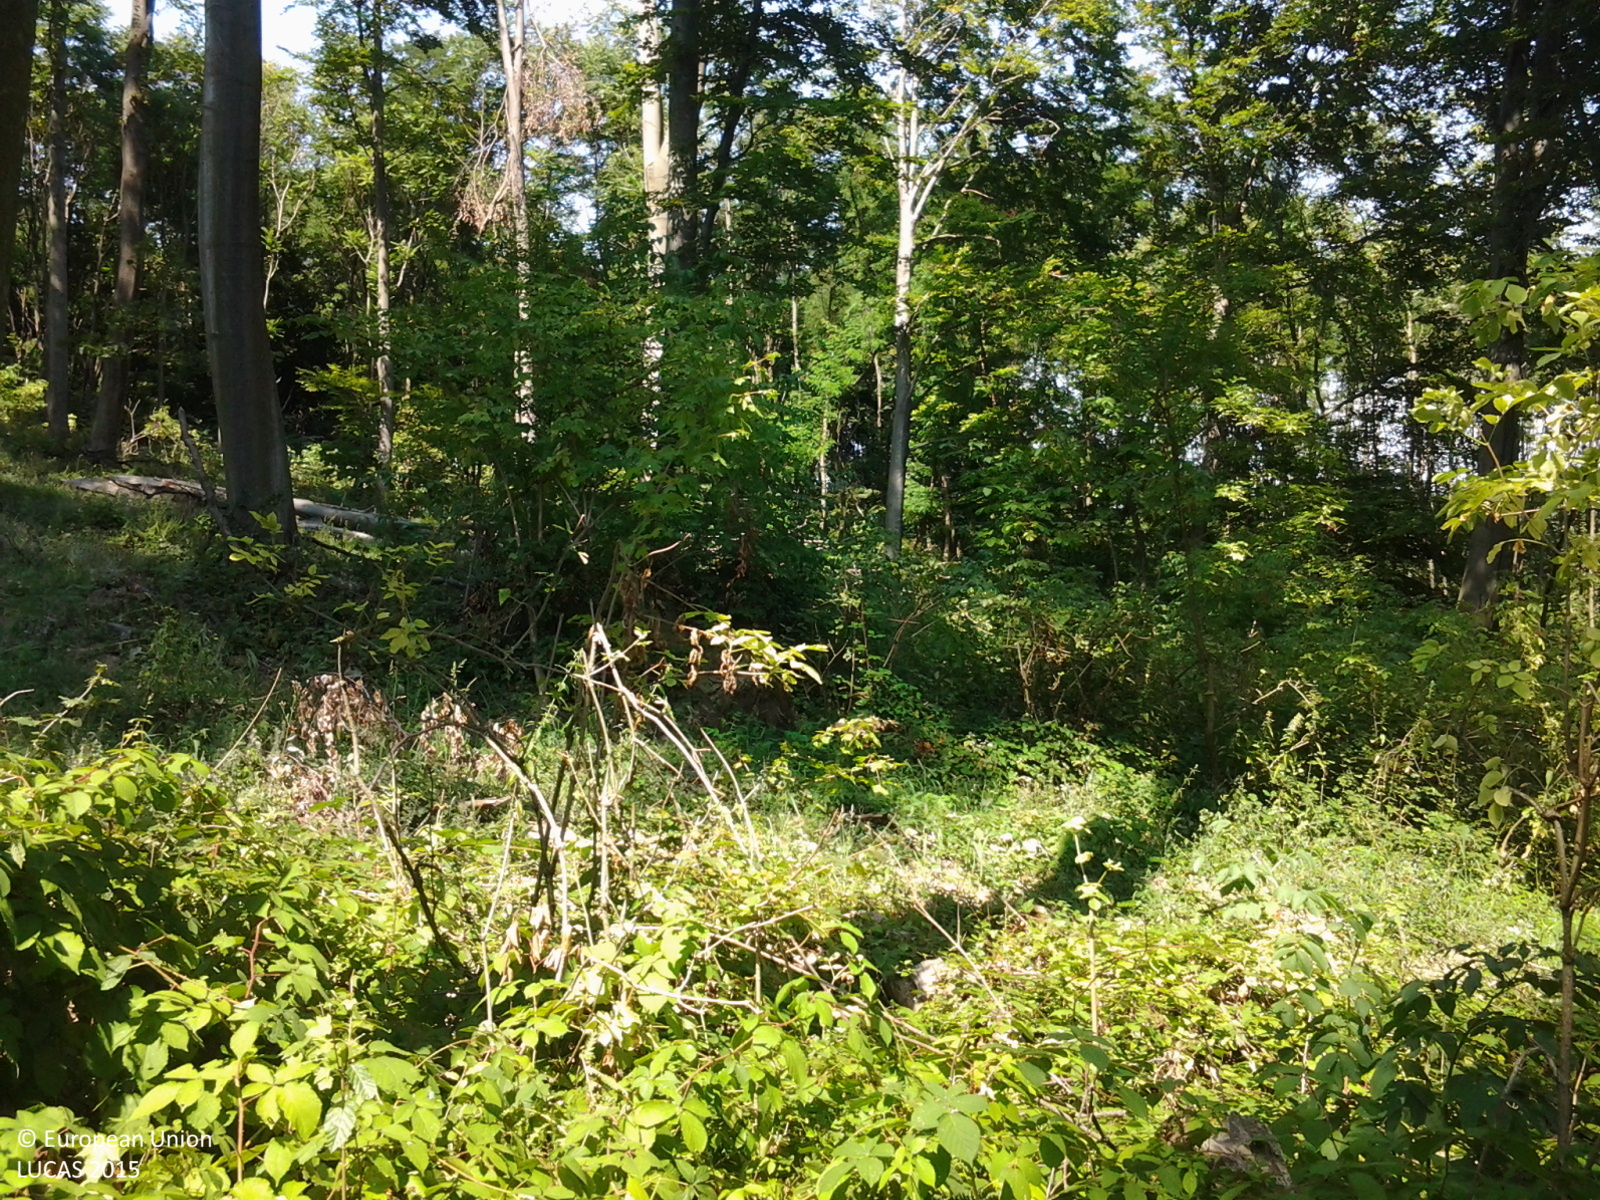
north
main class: Woodland
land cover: Broadleaved woodland
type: beech forest
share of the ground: > 75 %
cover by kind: broadleaved forest trees 85 %, herbaceous plants 10 %, shrubs 5 %
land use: Forestry
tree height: > 5 m
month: August
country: HU
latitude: 46.5713
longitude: 17.0357
